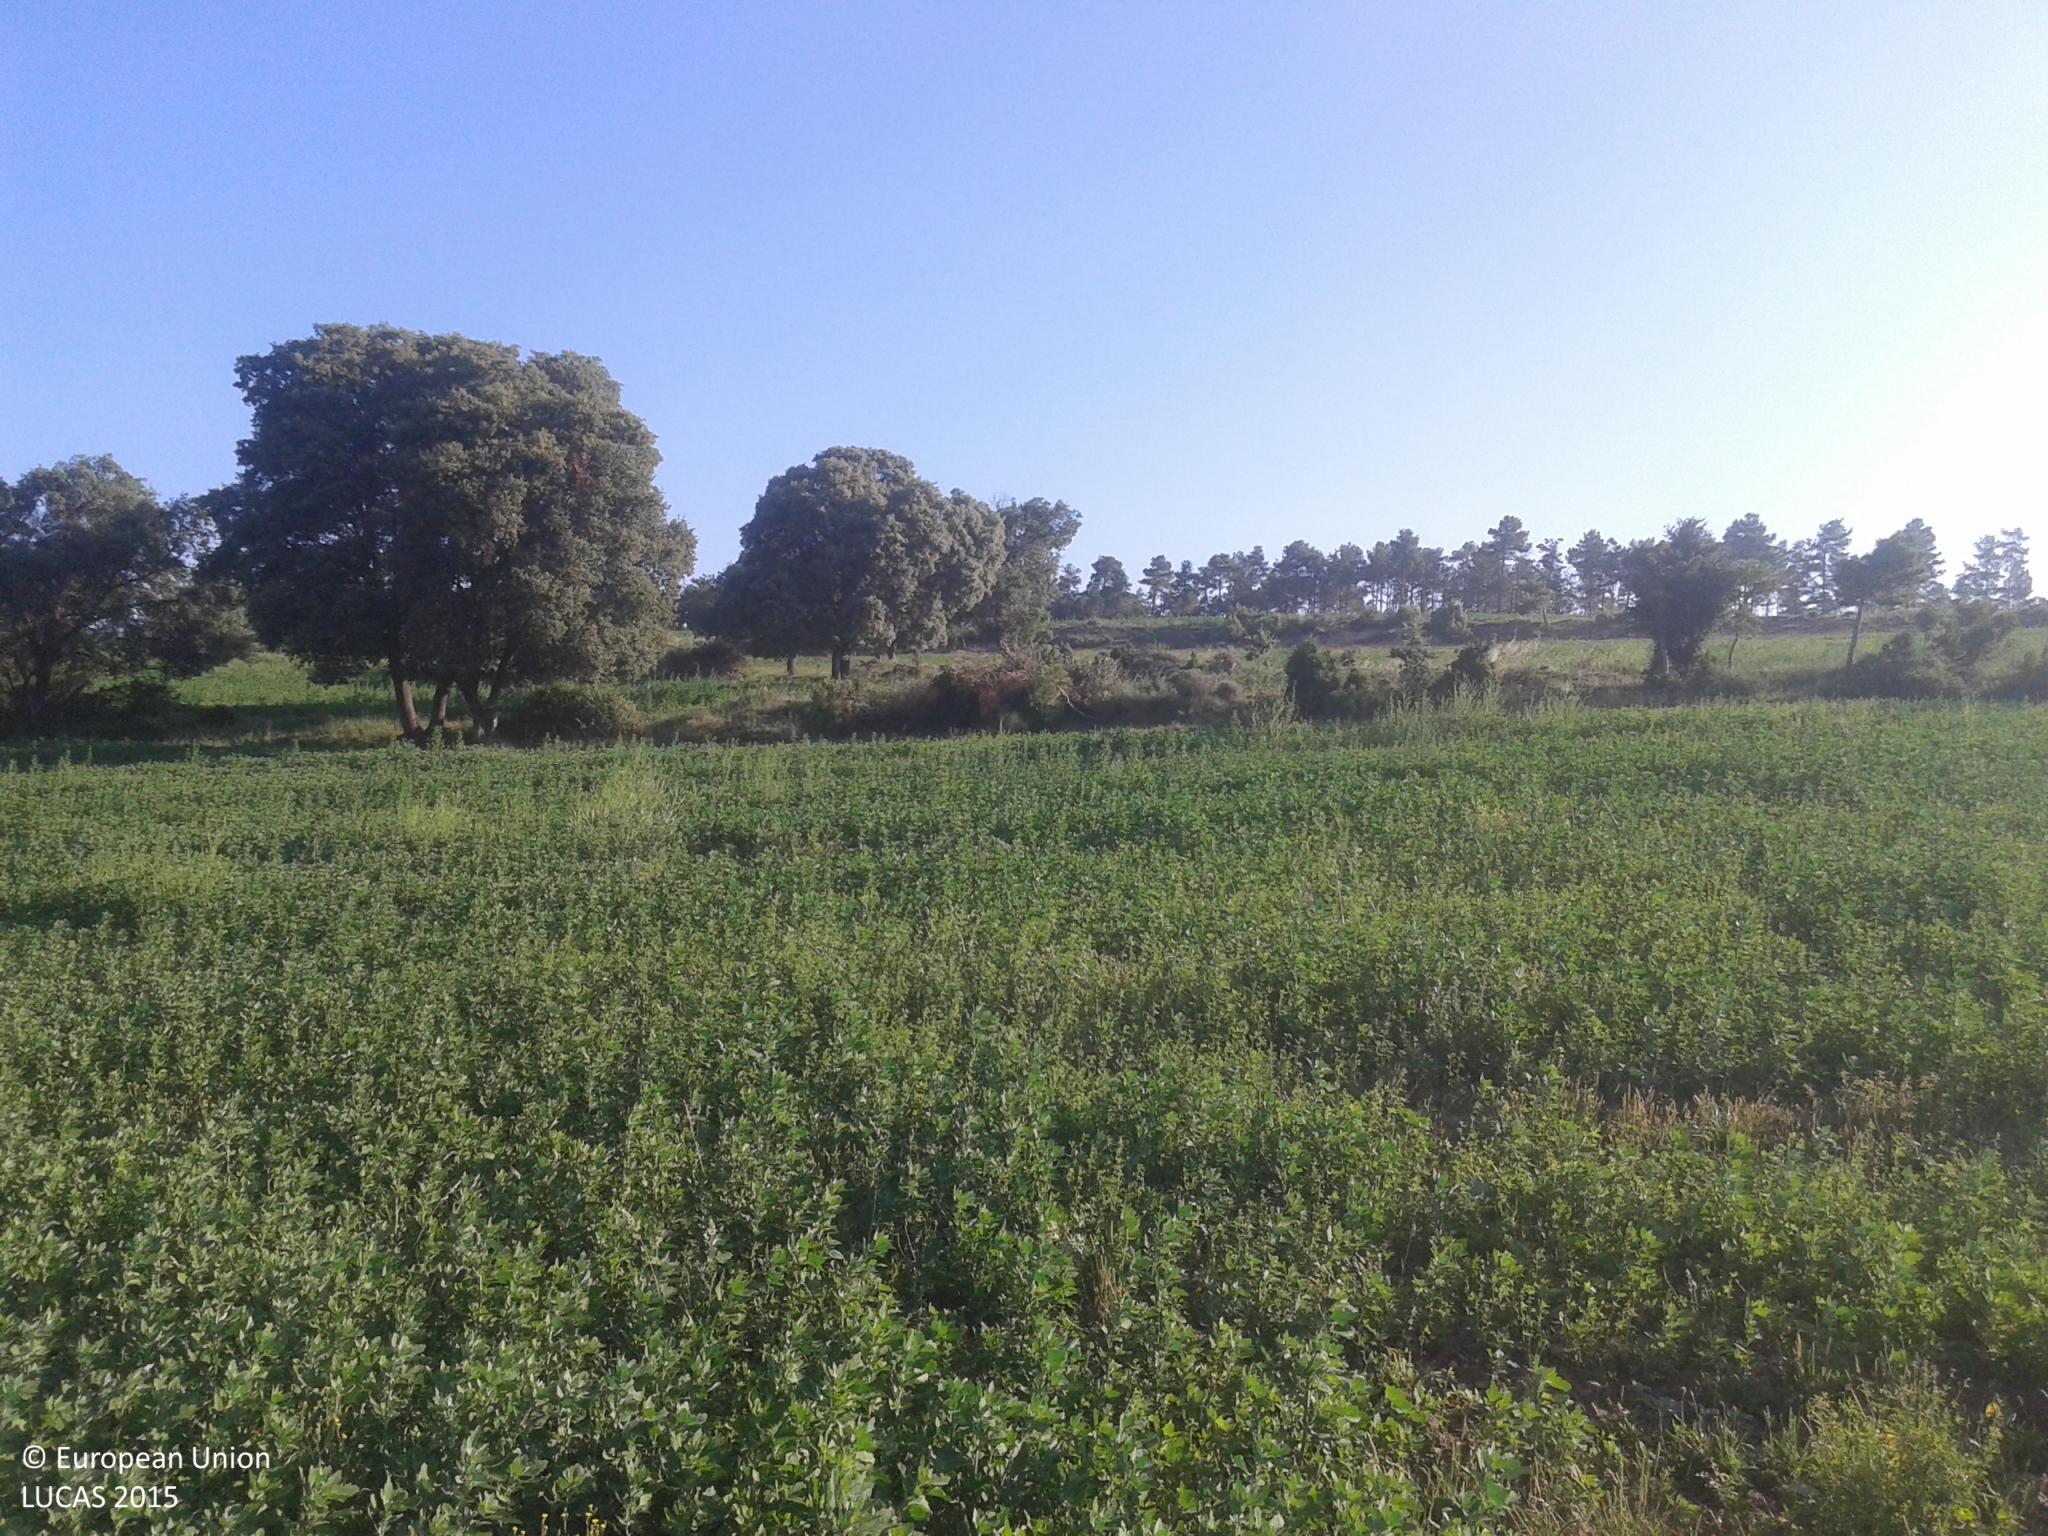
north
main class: Cropland
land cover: Temporary grasslands
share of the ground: > 75 %
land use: Agriculture (excluding fallow land and kitchen gardens)
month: June
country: ES
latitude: 42.0278
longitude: 1.5457
